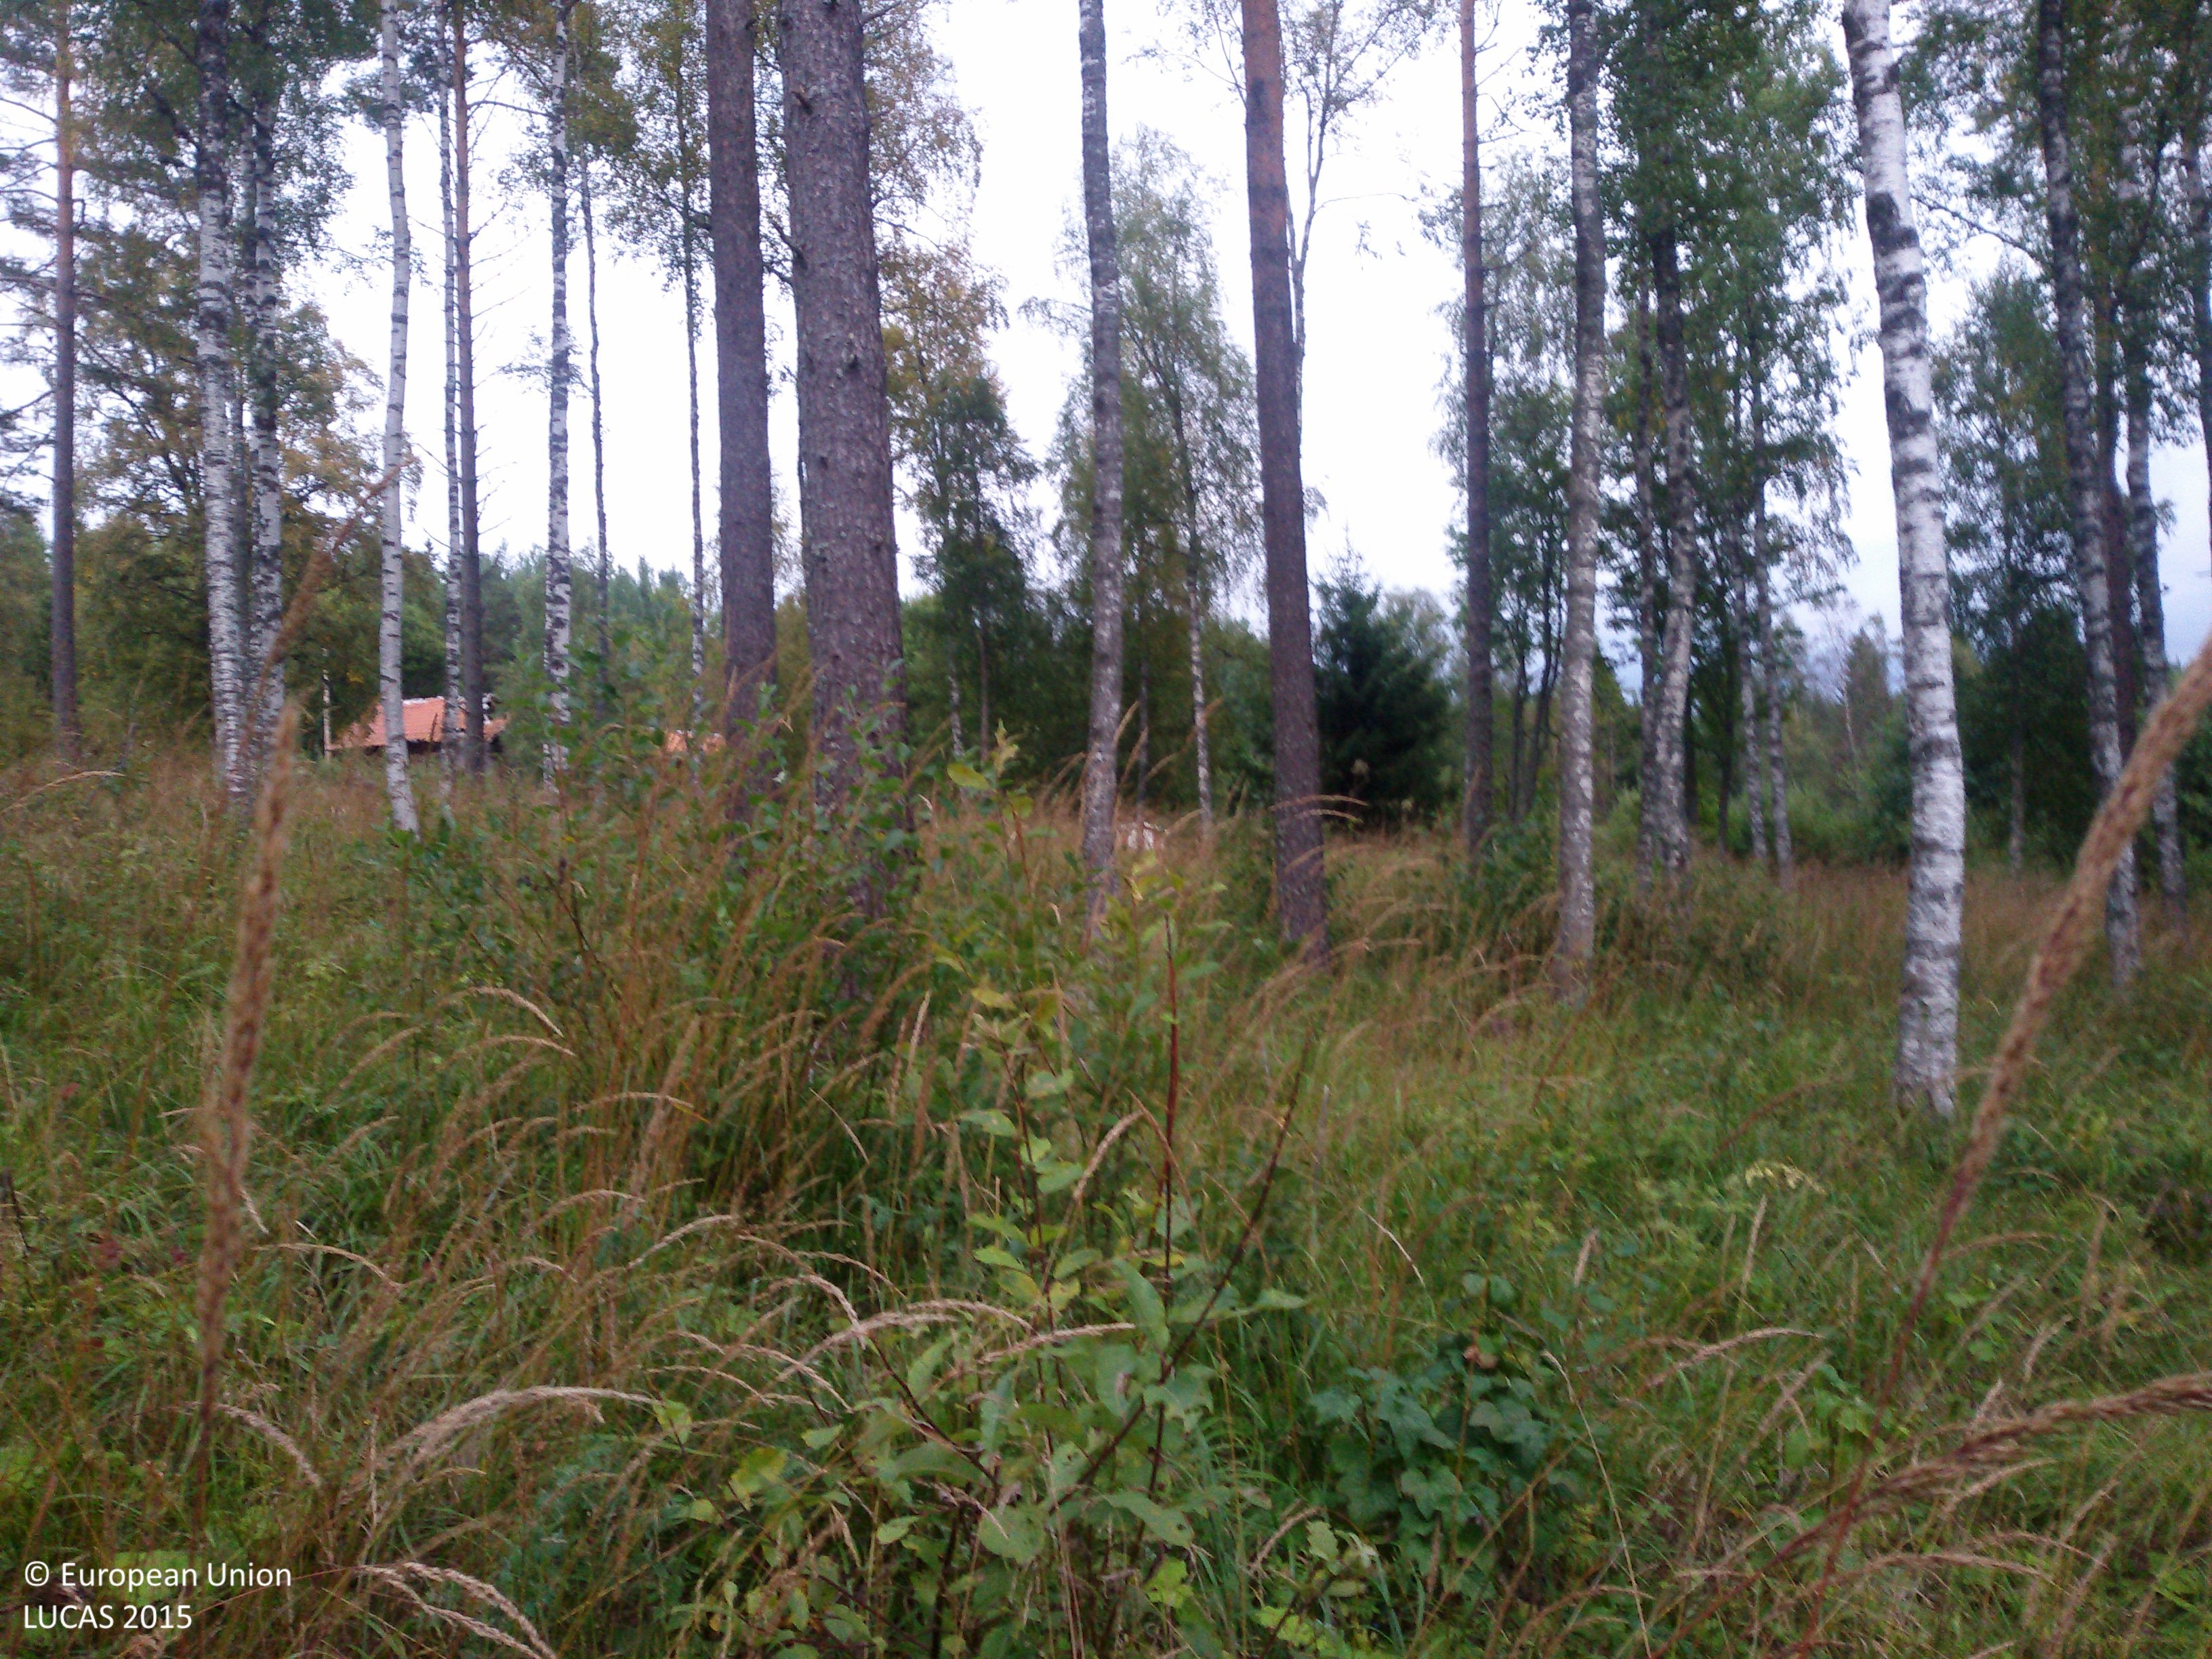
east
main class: Woodland
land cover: Pine dominated mixed woodland
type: boreal forest
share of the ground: 25 - 50 %
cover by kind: herbaceous plants 70 %, coniferous forest trees 15 %, broadleaved forest trees 15 %
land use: Forestry
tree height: > 5 m
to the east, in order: Pine dominated mixed woodland; Spontaneously vegetated surfaces; Ditches and canals; Paved roads, cycling and walking lanes; Shrubland with sparse tree cover; Artificial constructions in urban areas; Broadleaved woodland; Grassland with sparse tree/shrub cover
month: September
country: SE
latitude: 60.8184
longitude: 15.3737
